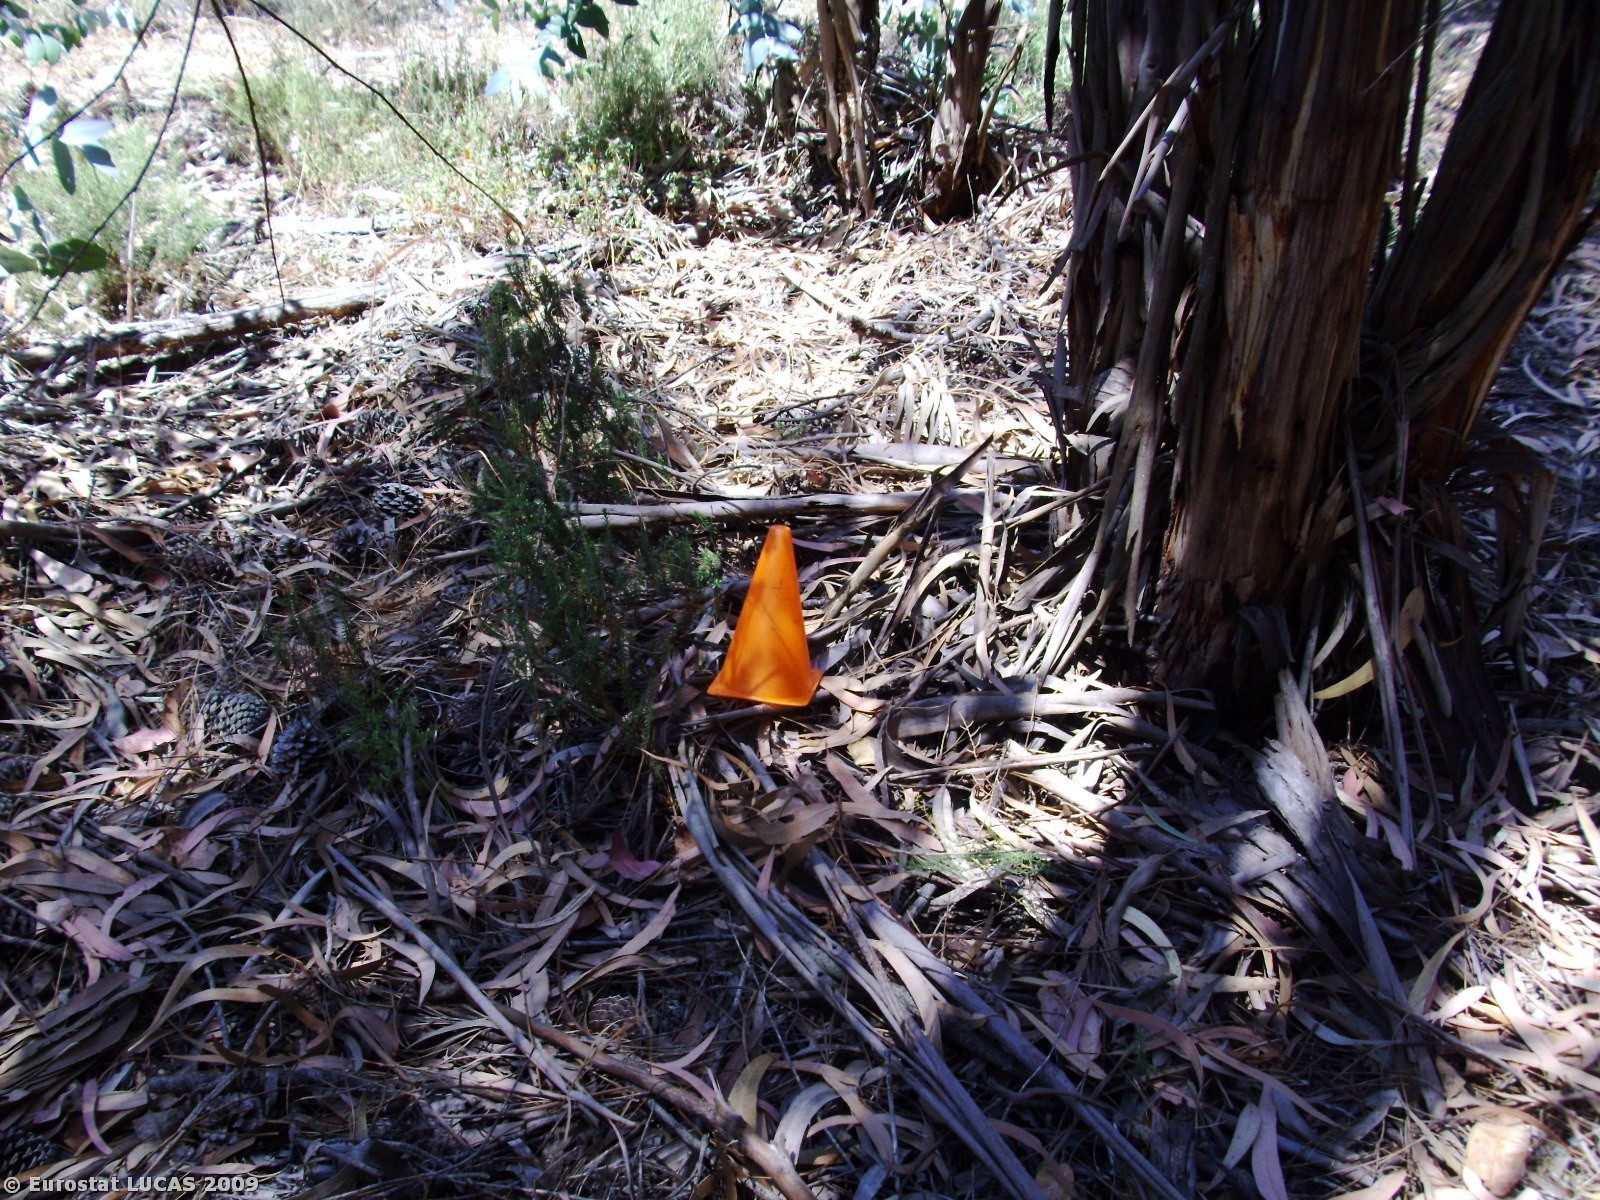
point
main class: Woodland
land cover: Broadleaved woodland
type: plantations and self-sown exotic forest
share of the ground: 50 - 75 %
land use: Forestry
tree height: > 5 m
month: June
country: PT
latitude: 38.1791
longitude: -8.7641
